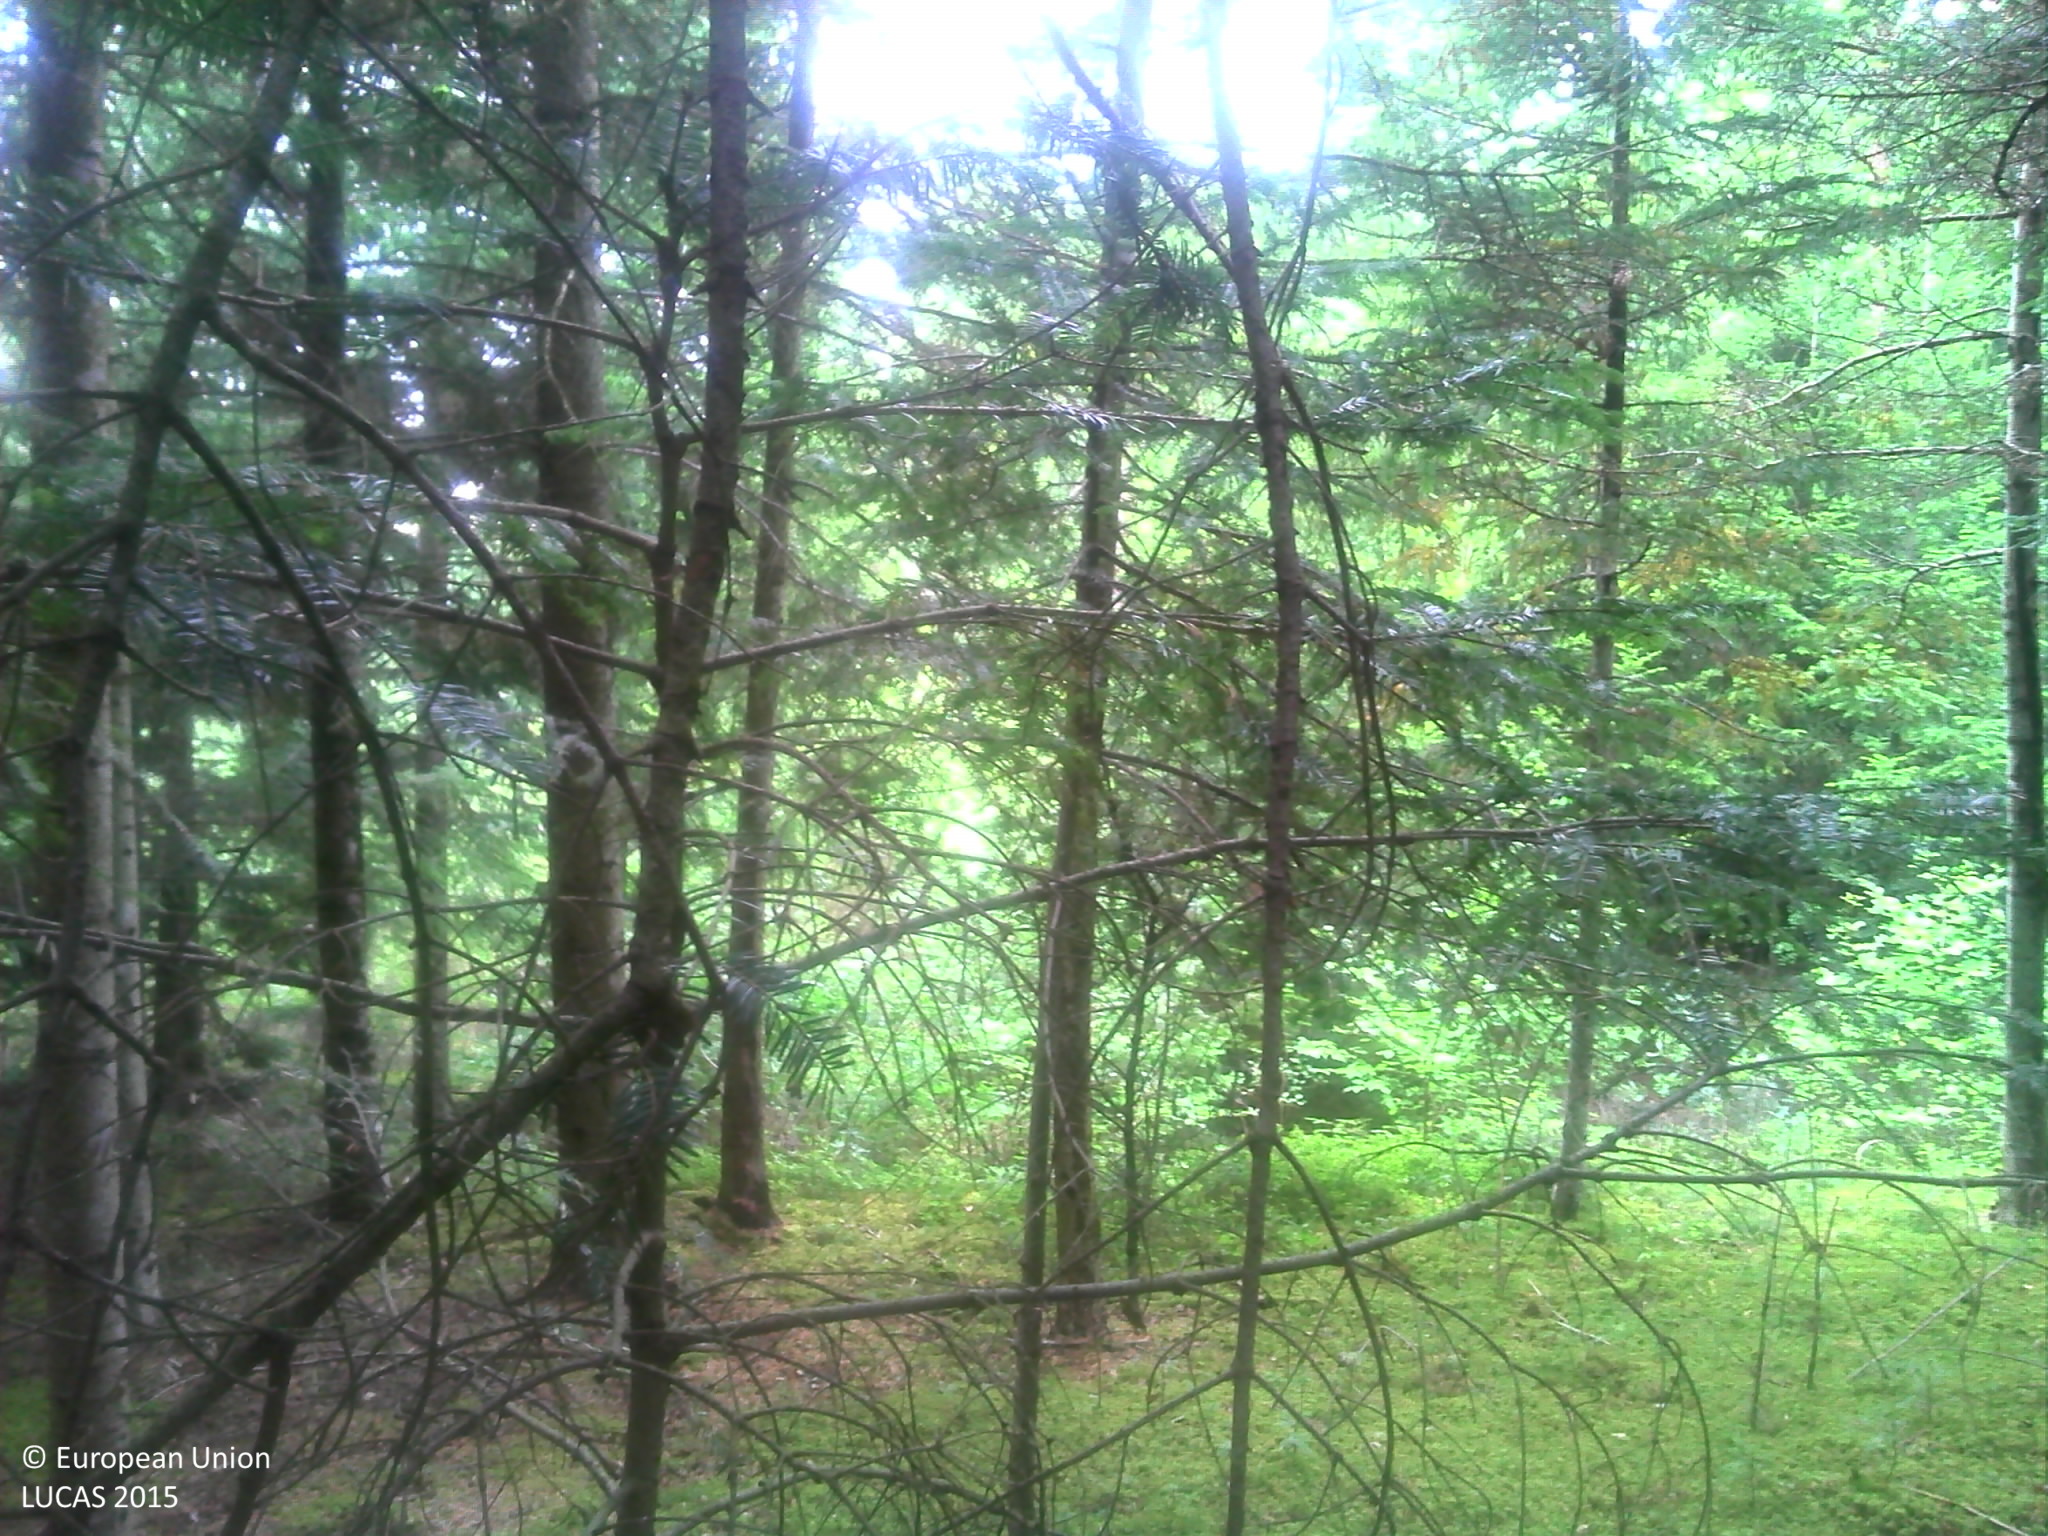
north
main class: Woodland
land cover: Spruce dominated coniferous woodland
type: exotic forest
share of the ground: > 75 %
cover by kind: coniferous forest trees 80 %, lichens and mosses 10 %, herbaceous plants 5 %, unconsolidated bare surface 5 %
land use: Forestry
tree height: > 5 m
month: July
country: FR
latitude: 45.1630
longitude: 3.8590
